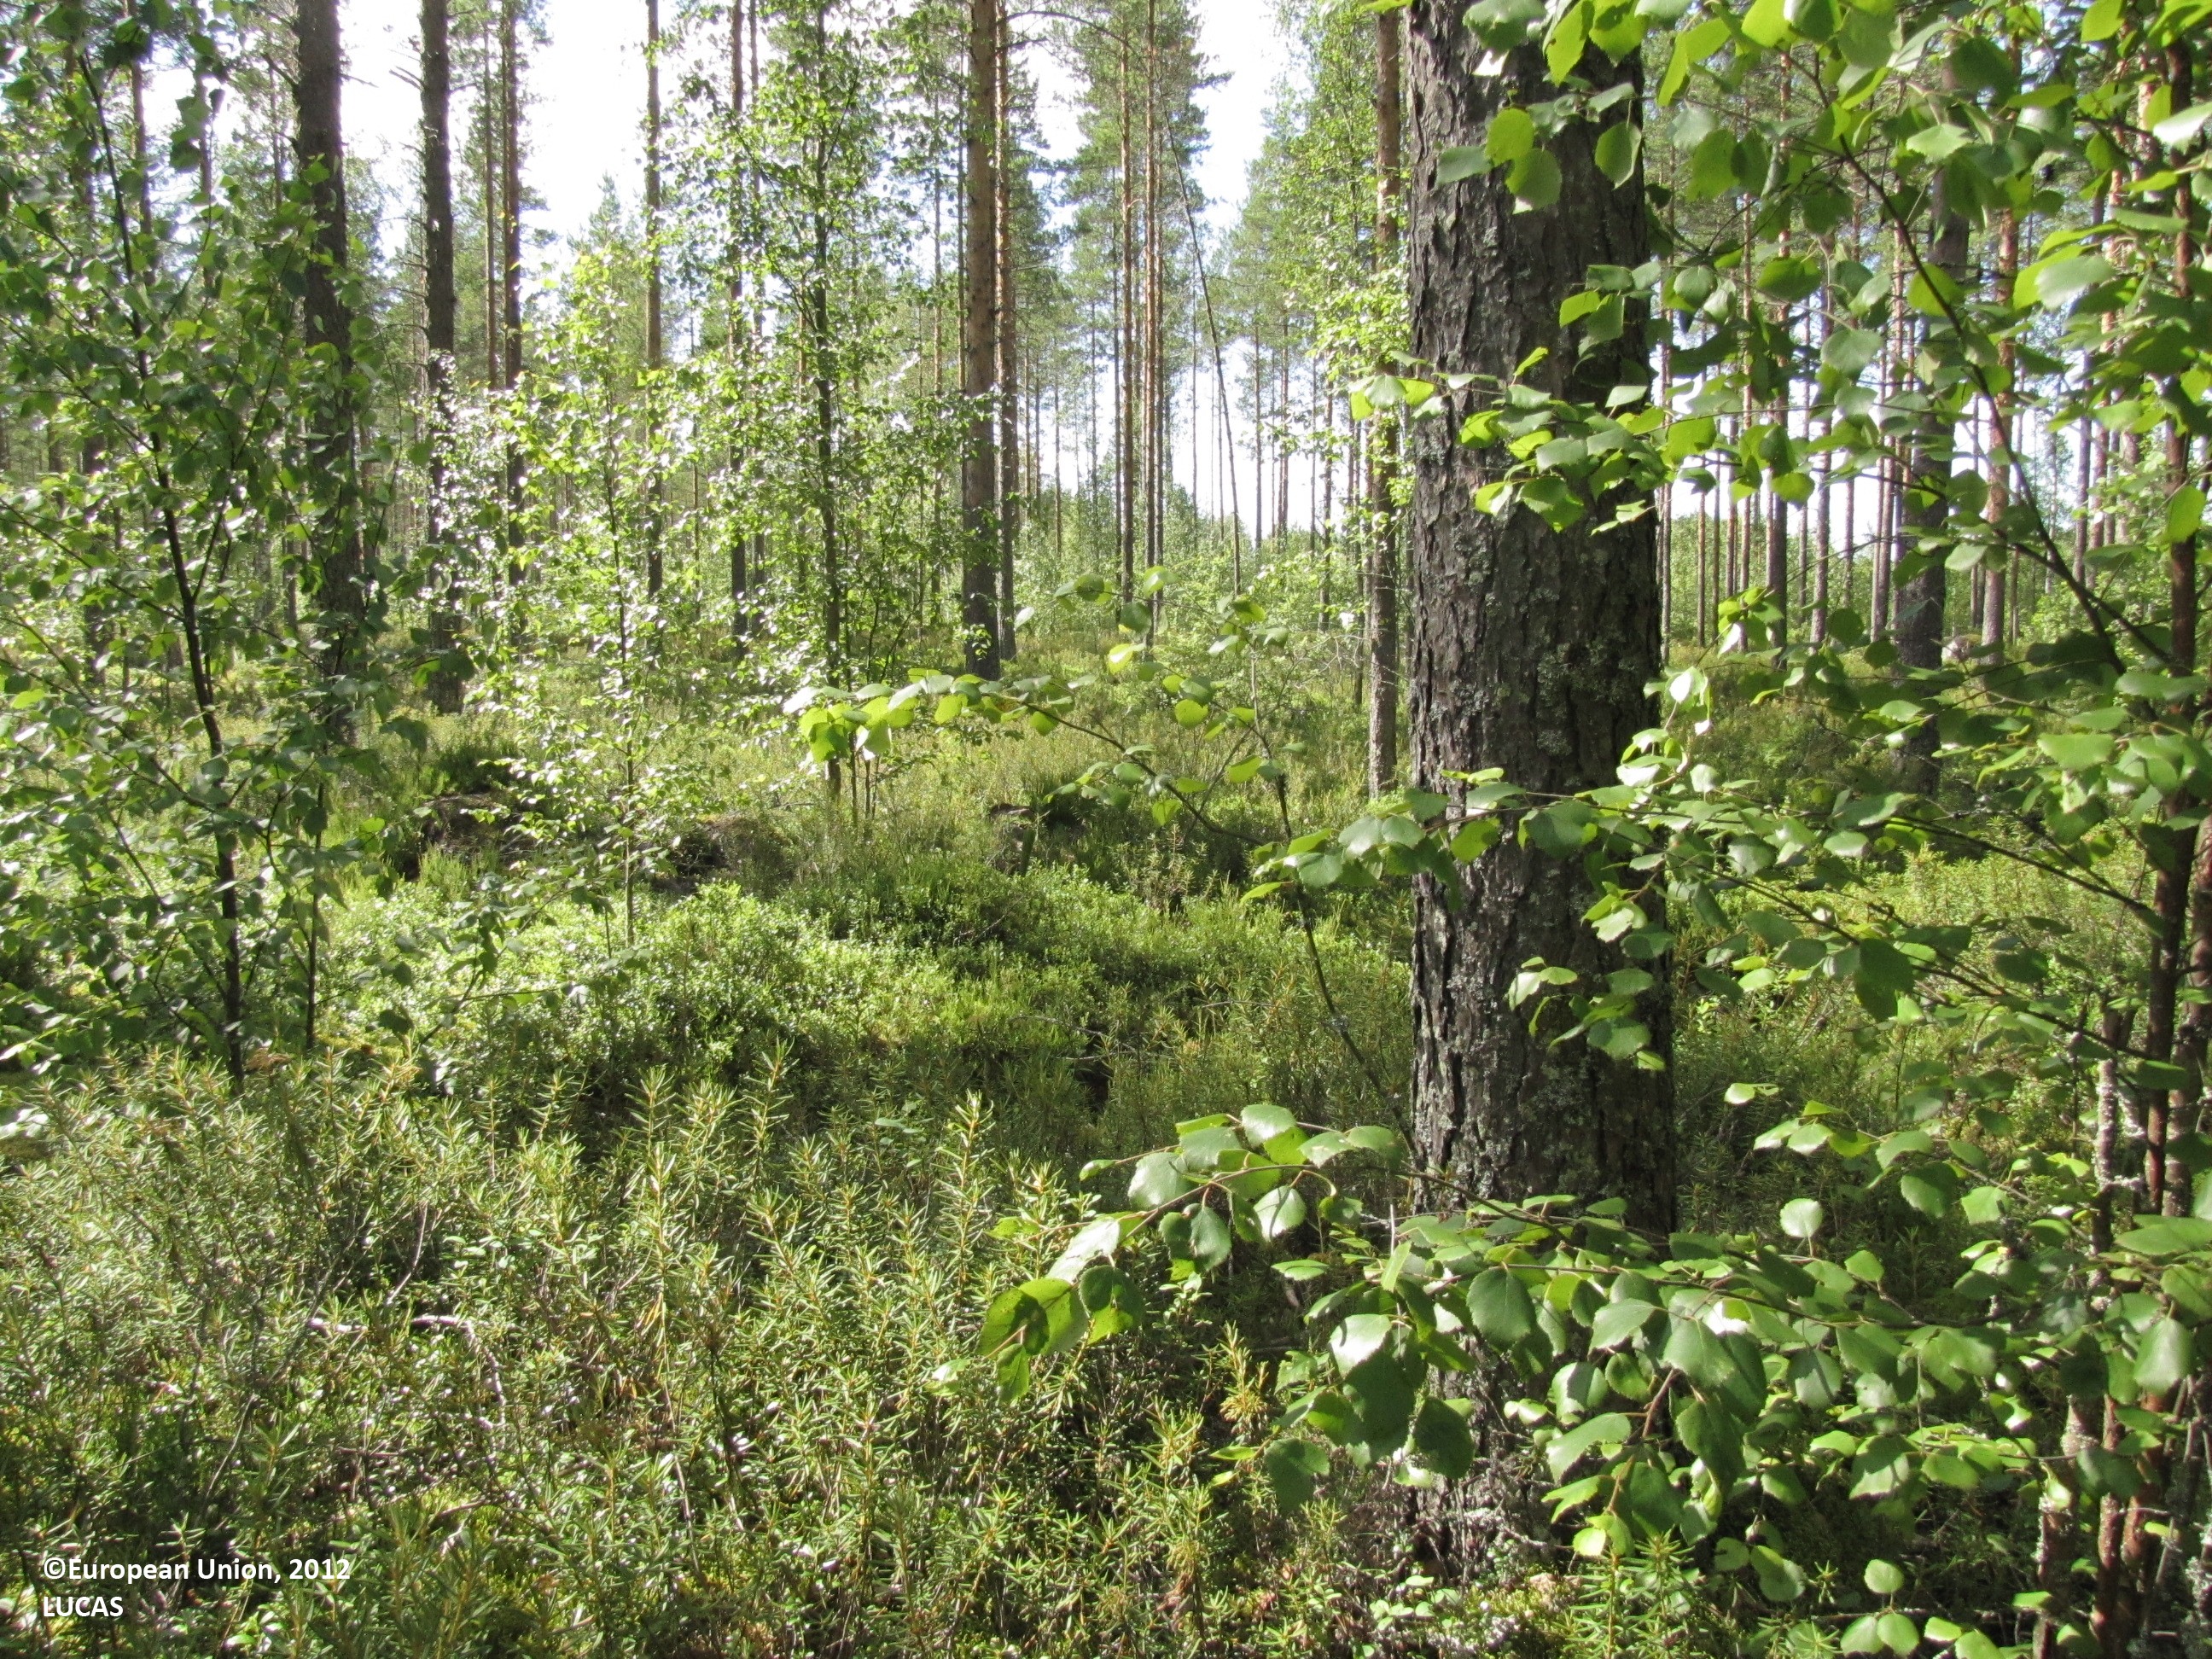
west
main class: Woodland
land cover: Pine dominated coniferous woodland
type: boreal forest
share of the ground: 50 - 75 %
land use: Forestry
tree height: > 5 m
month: July
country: FI
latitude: 62.4398
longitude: 23.1035
